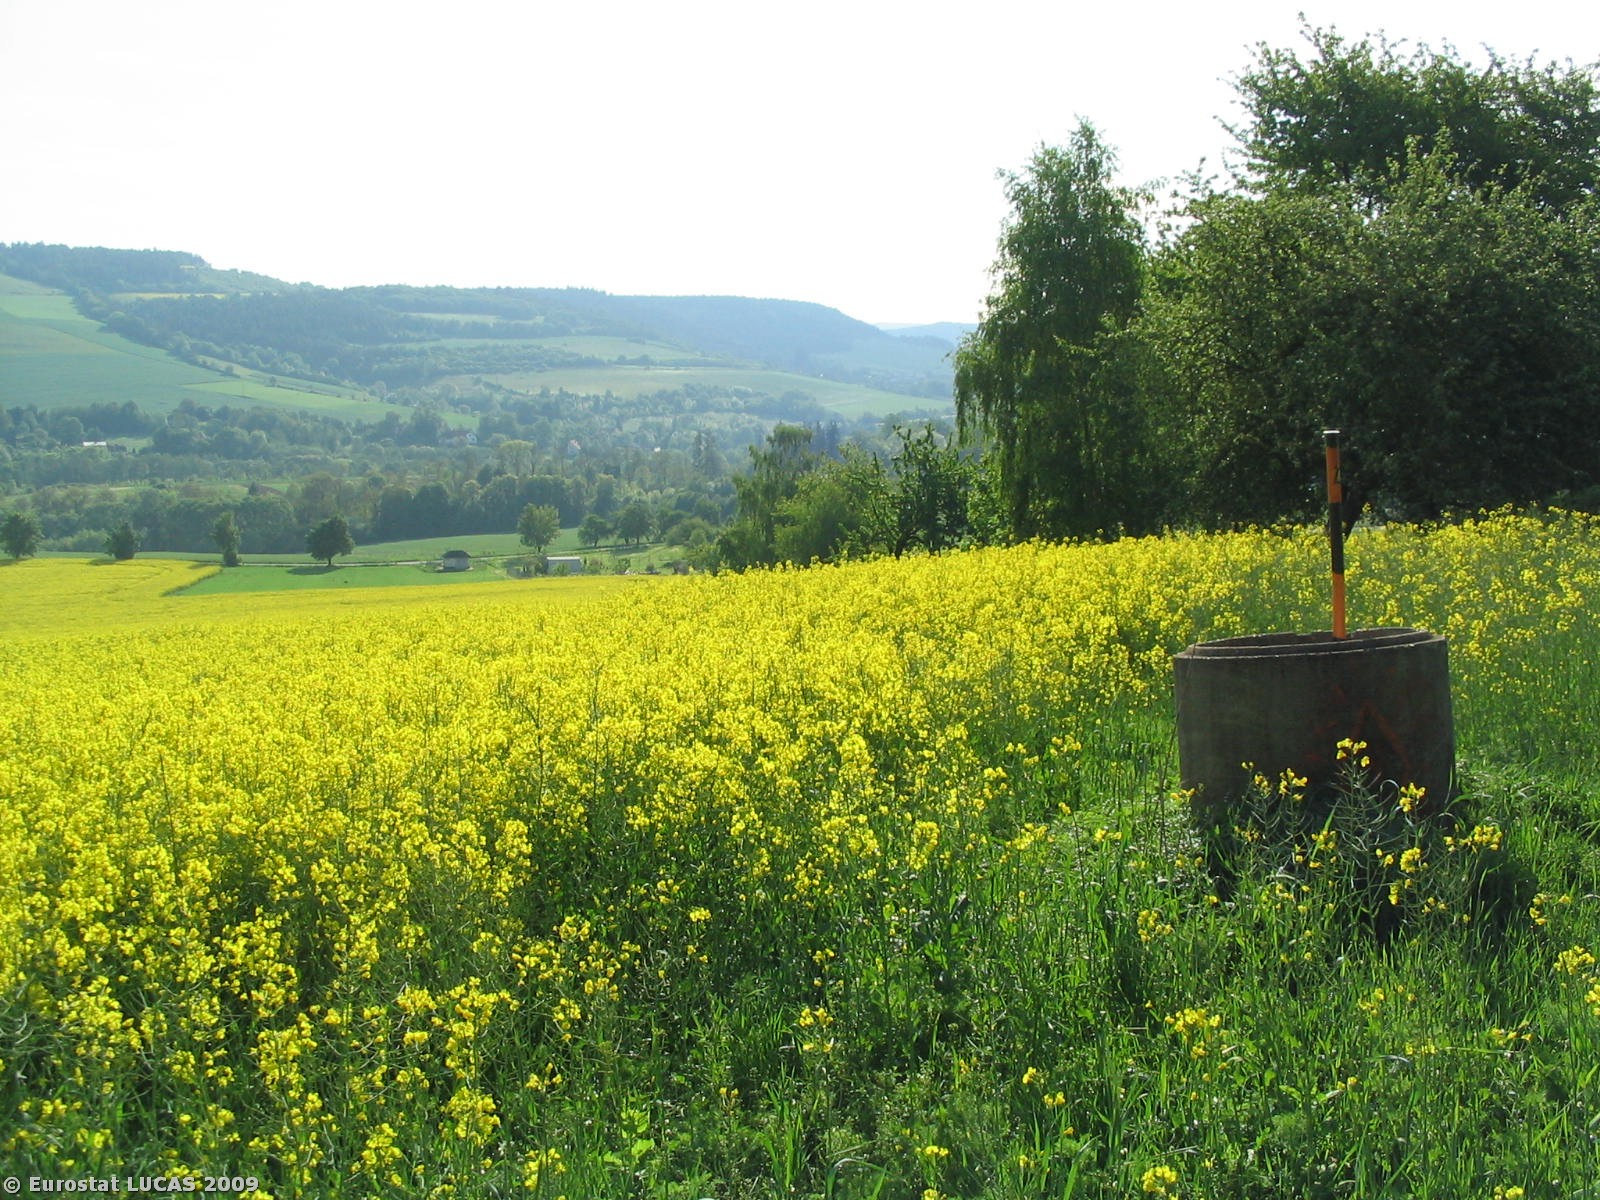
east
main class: Cropland
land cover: Rape and turnip rape
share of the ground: > 75 %
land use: Agriculture (excluding fallow land and kitchen gardens)
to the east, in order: Rape and turnip rape
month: May
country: CZ
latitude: 49.5662
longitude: 16.4919
